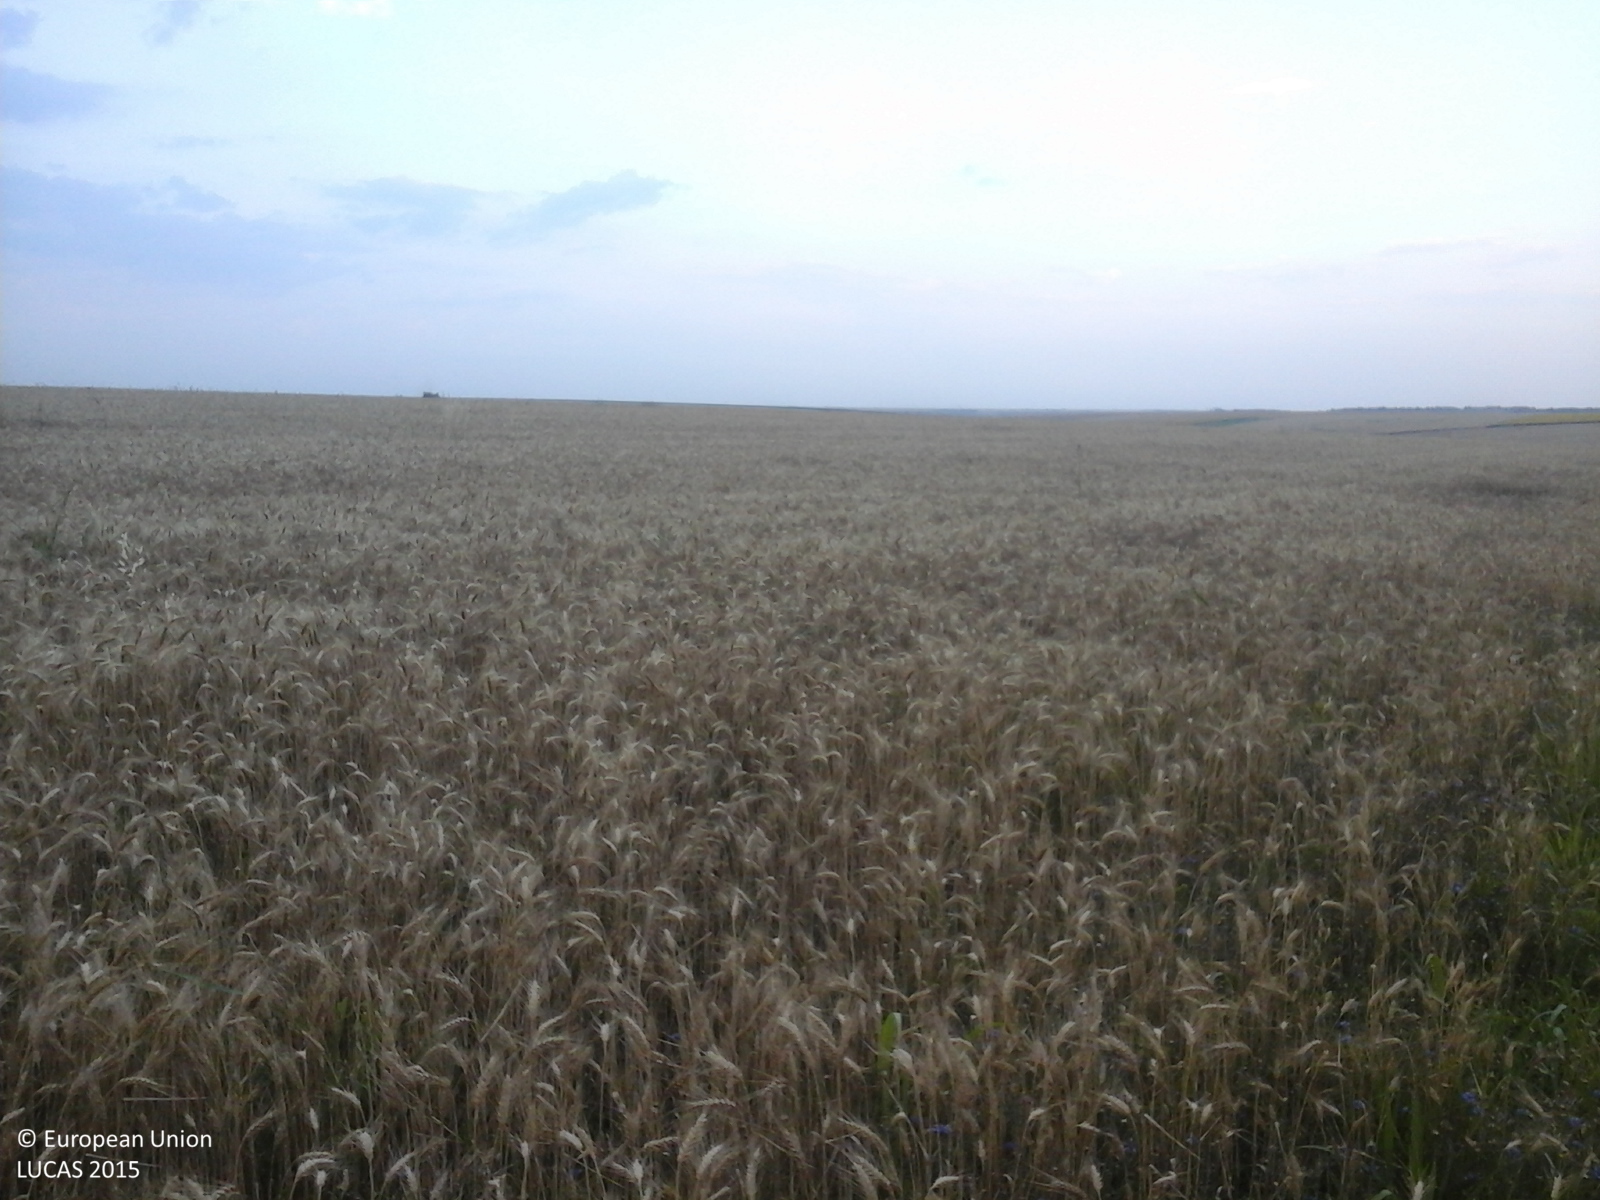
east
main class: Cropland
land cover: Common wheat
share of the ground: > 75 %
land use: Agriculture (excluding fallow land and kitchen gardens)
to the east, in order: Common wheat
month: July
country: RO
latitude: 43.9825
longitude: 24.7704
